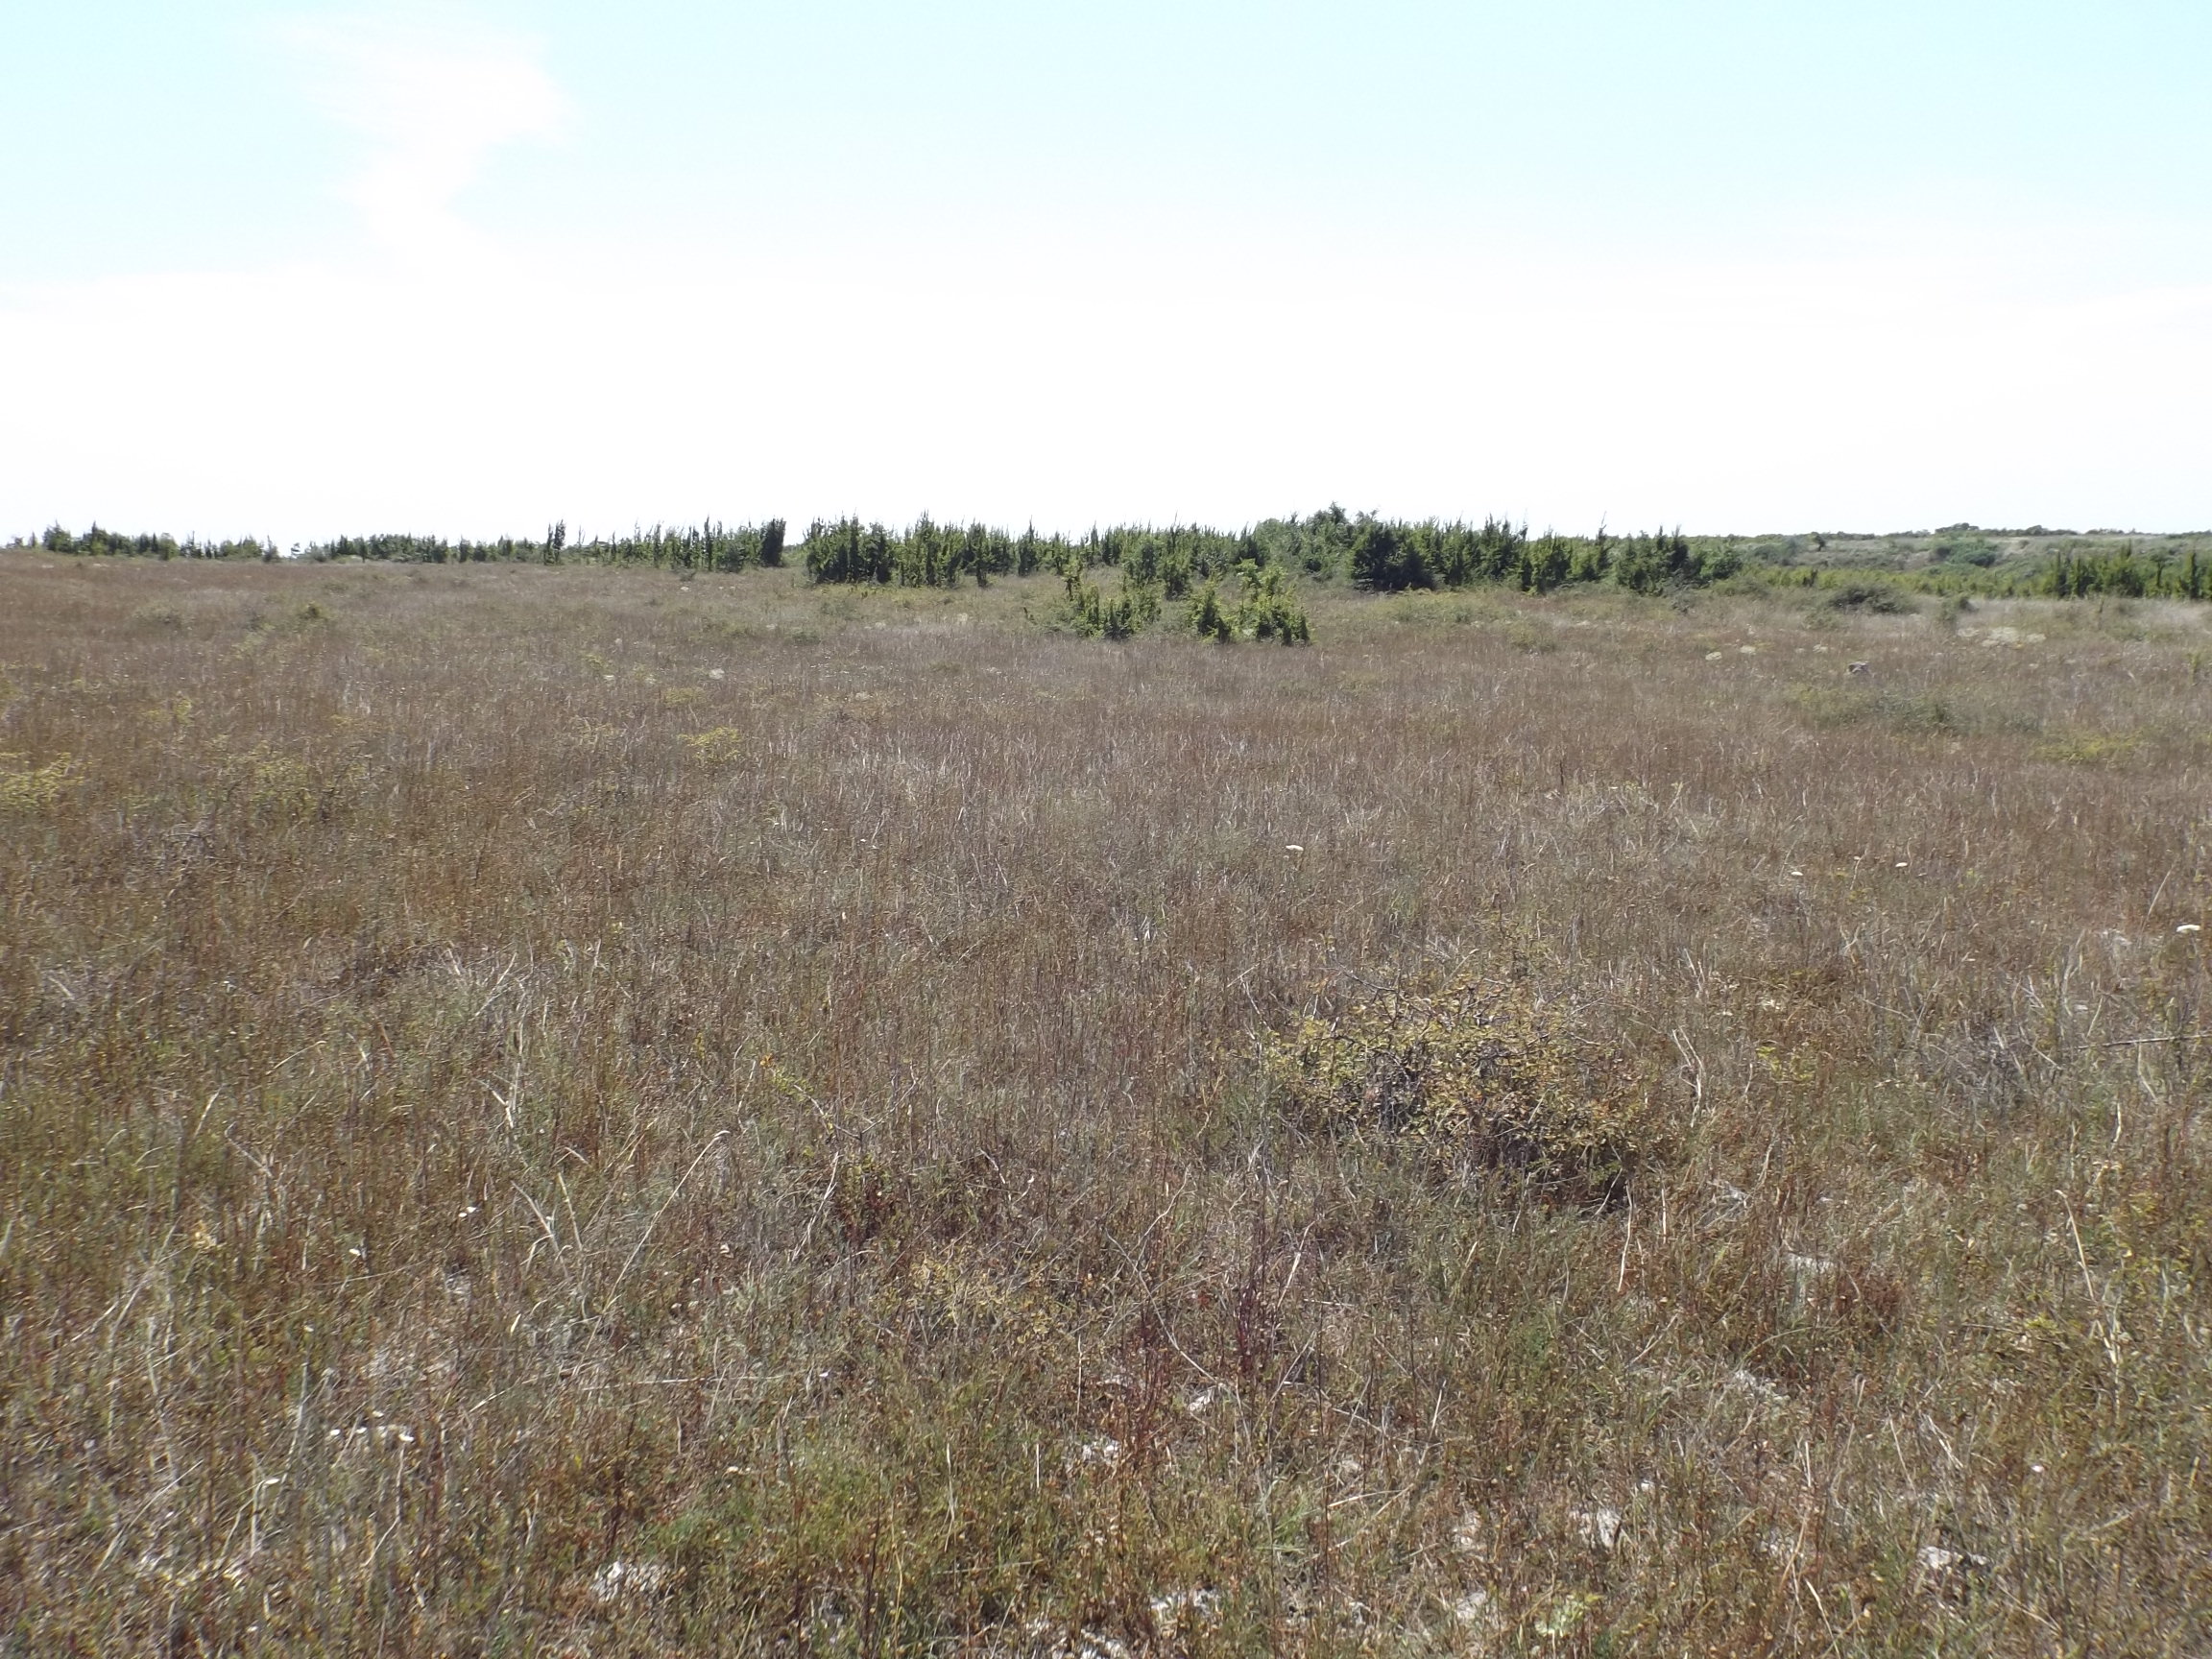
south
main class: Grassland
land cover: Grassland without tree/shrub cover
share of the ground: > 75 %
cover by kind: herbaceous plants 100 %
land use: Semi-natural and natural areas not in use
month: August
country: BG
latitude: 43.2600
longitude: 27.9921
